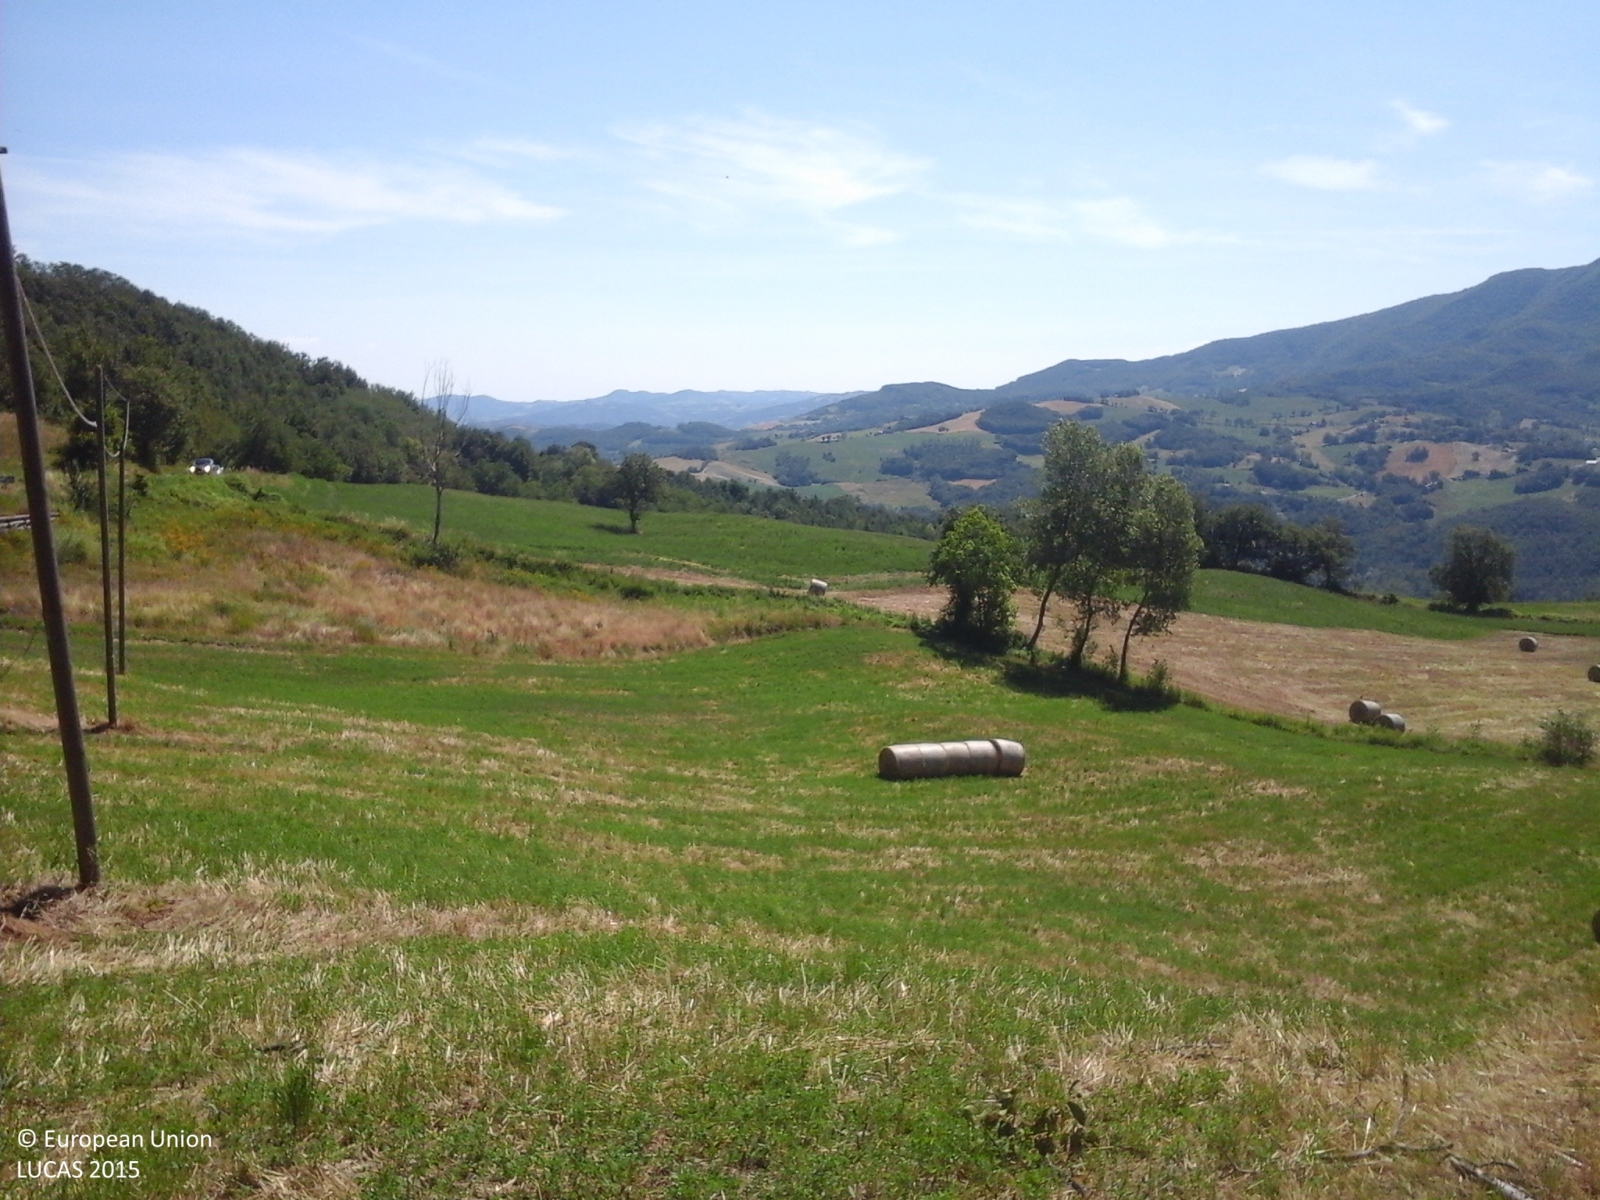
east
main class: Cropland
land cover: Common wheat
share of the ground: > 75 %
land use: Agriculture (excluding fallow land and kitchen gardens)
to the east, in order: Common wheat; Managed hedges; Rivers and streams; Lucerne; Managed hedges; Ditches and canals; Grass margins; Lucerne; Managed hedges; Tracks; Managed hedges; Lucerne
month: June
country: IT
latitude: 44.5307
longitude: 10.2134
